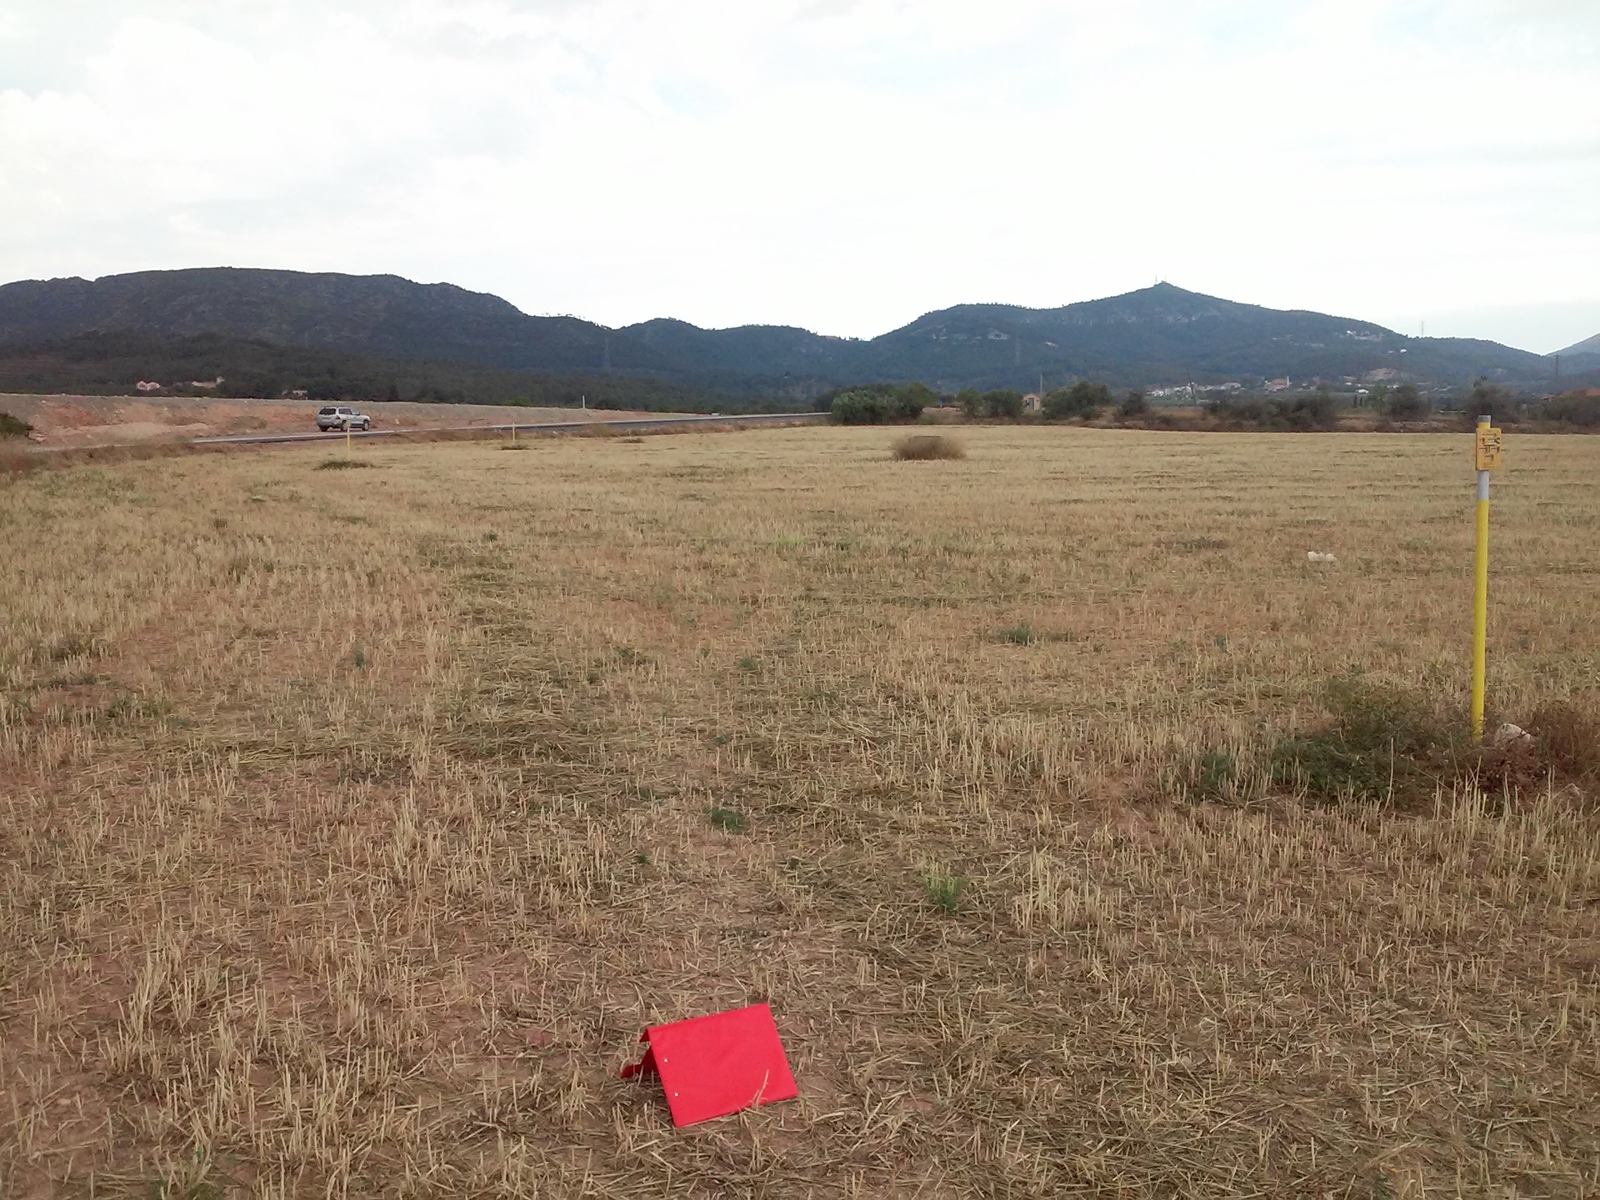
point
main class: Cropland
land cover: Barley
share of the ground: < 10 %
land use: Agriculture (excluding fallow land and kitchen gardens)
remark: Harvested field
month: June
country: ES
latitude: 41.3109
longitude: 1.2369
